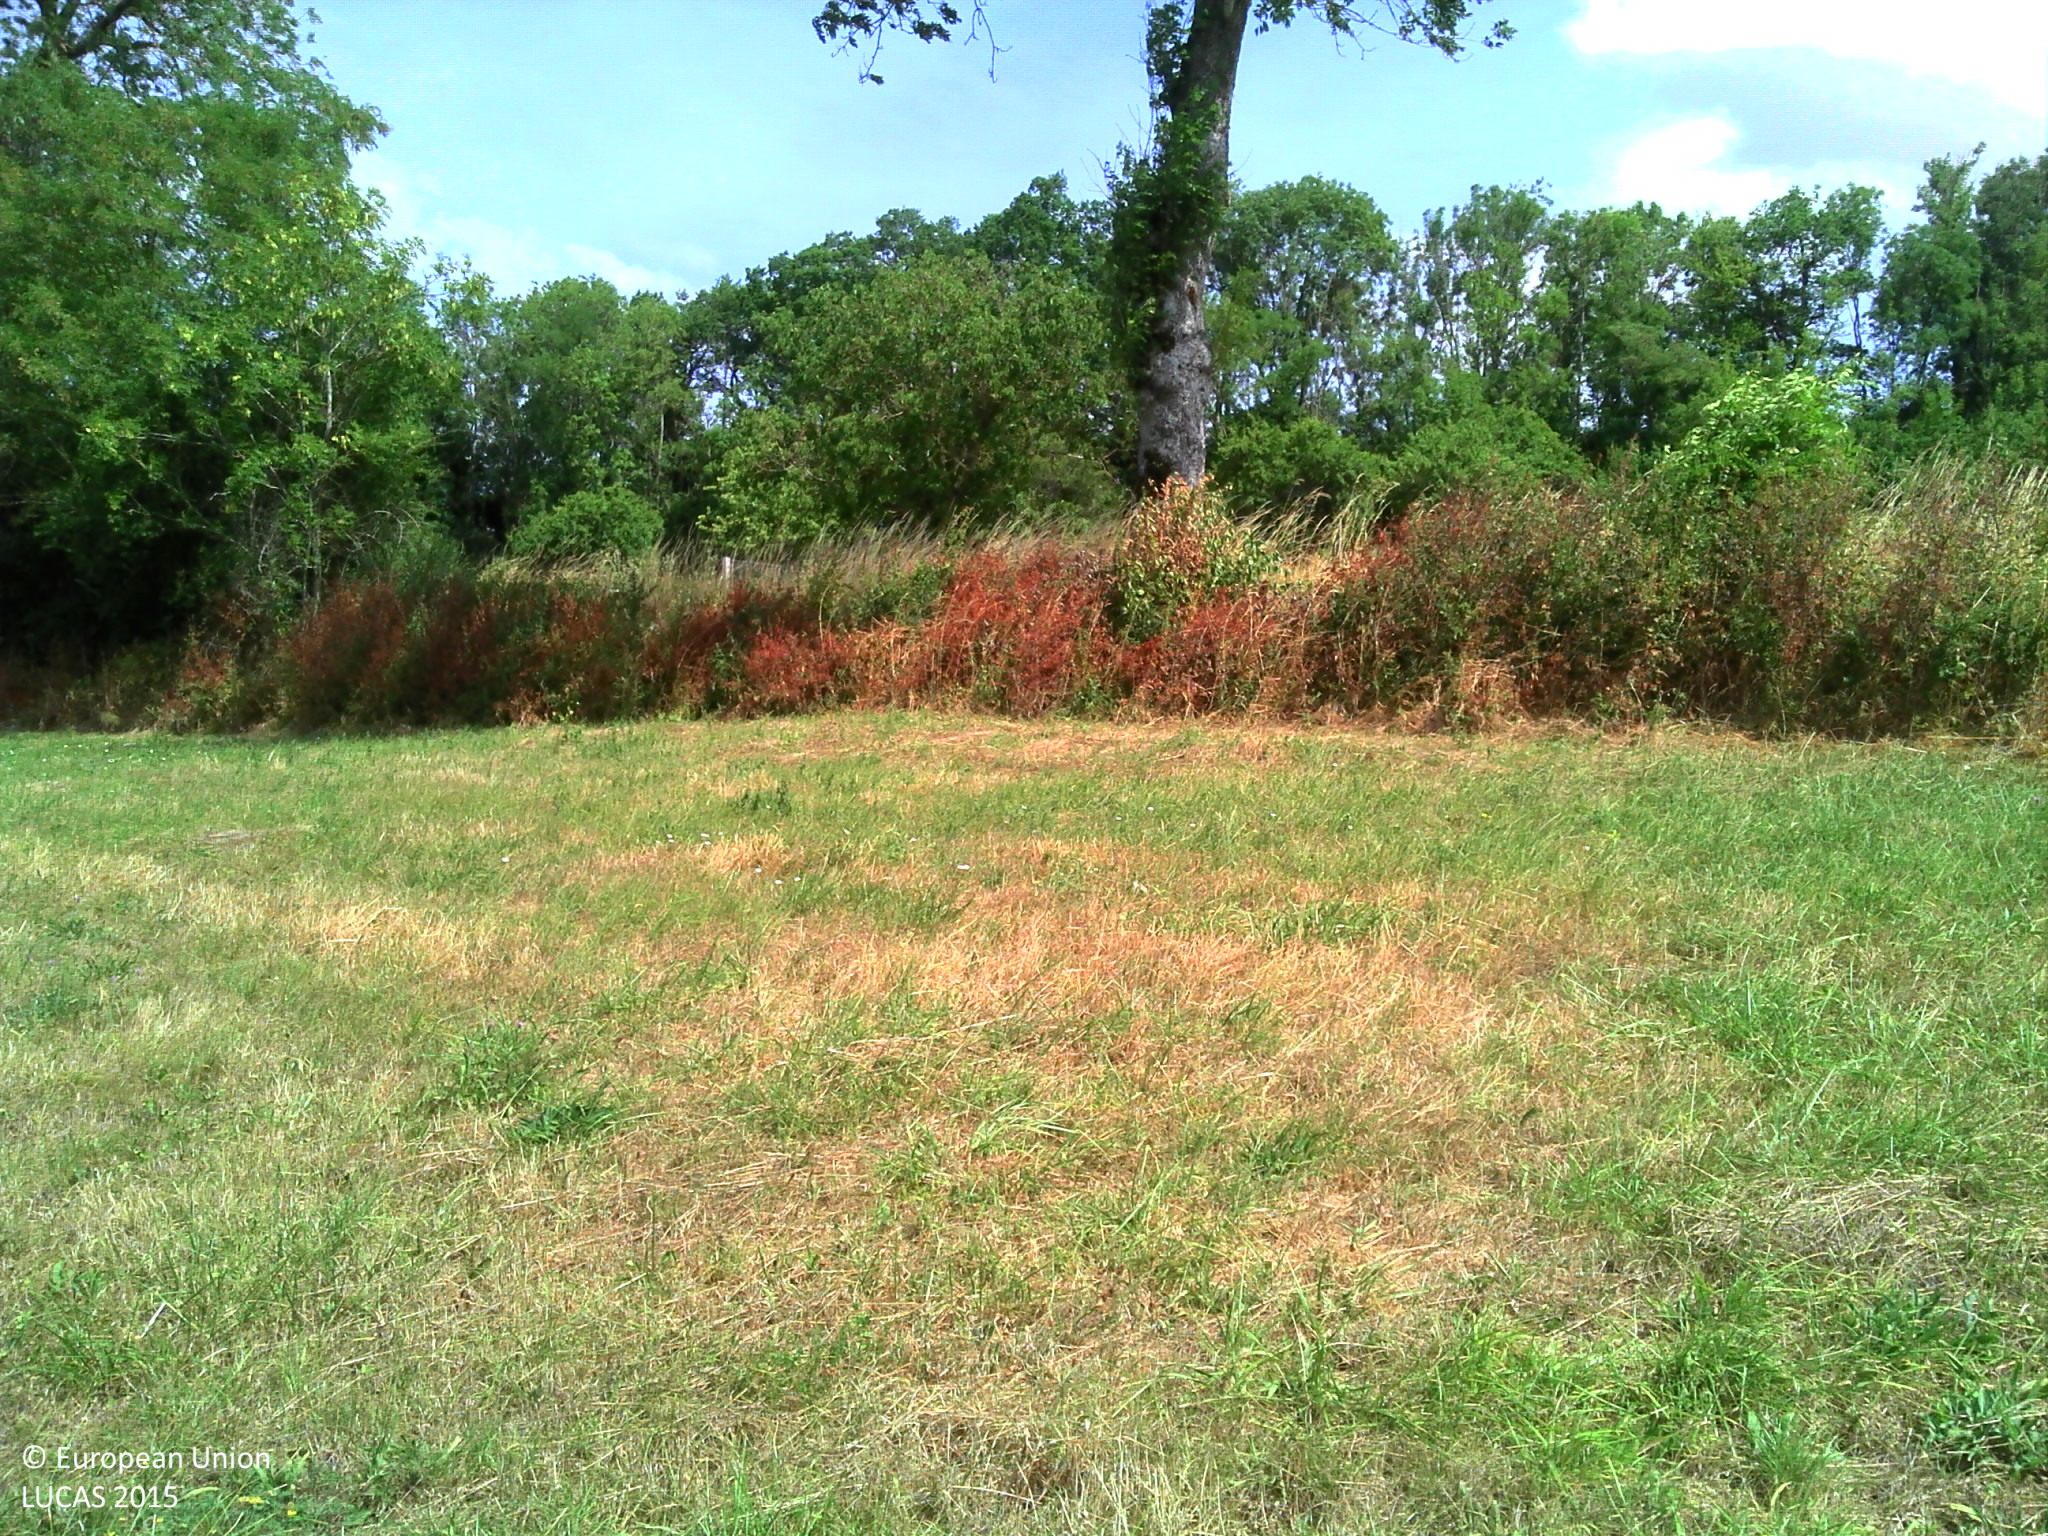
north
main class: Grassland
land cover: Grassland with sparse tree/shrub cover
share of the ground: > 75 %
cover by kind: herbaceous plants 95 %, broadleaved forest trees 5 %
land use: Agriculture (excluding fallow land and kitchen gardens)
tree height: > 5 m
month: July
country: FR
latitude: 48.4018
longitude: 5.9613
